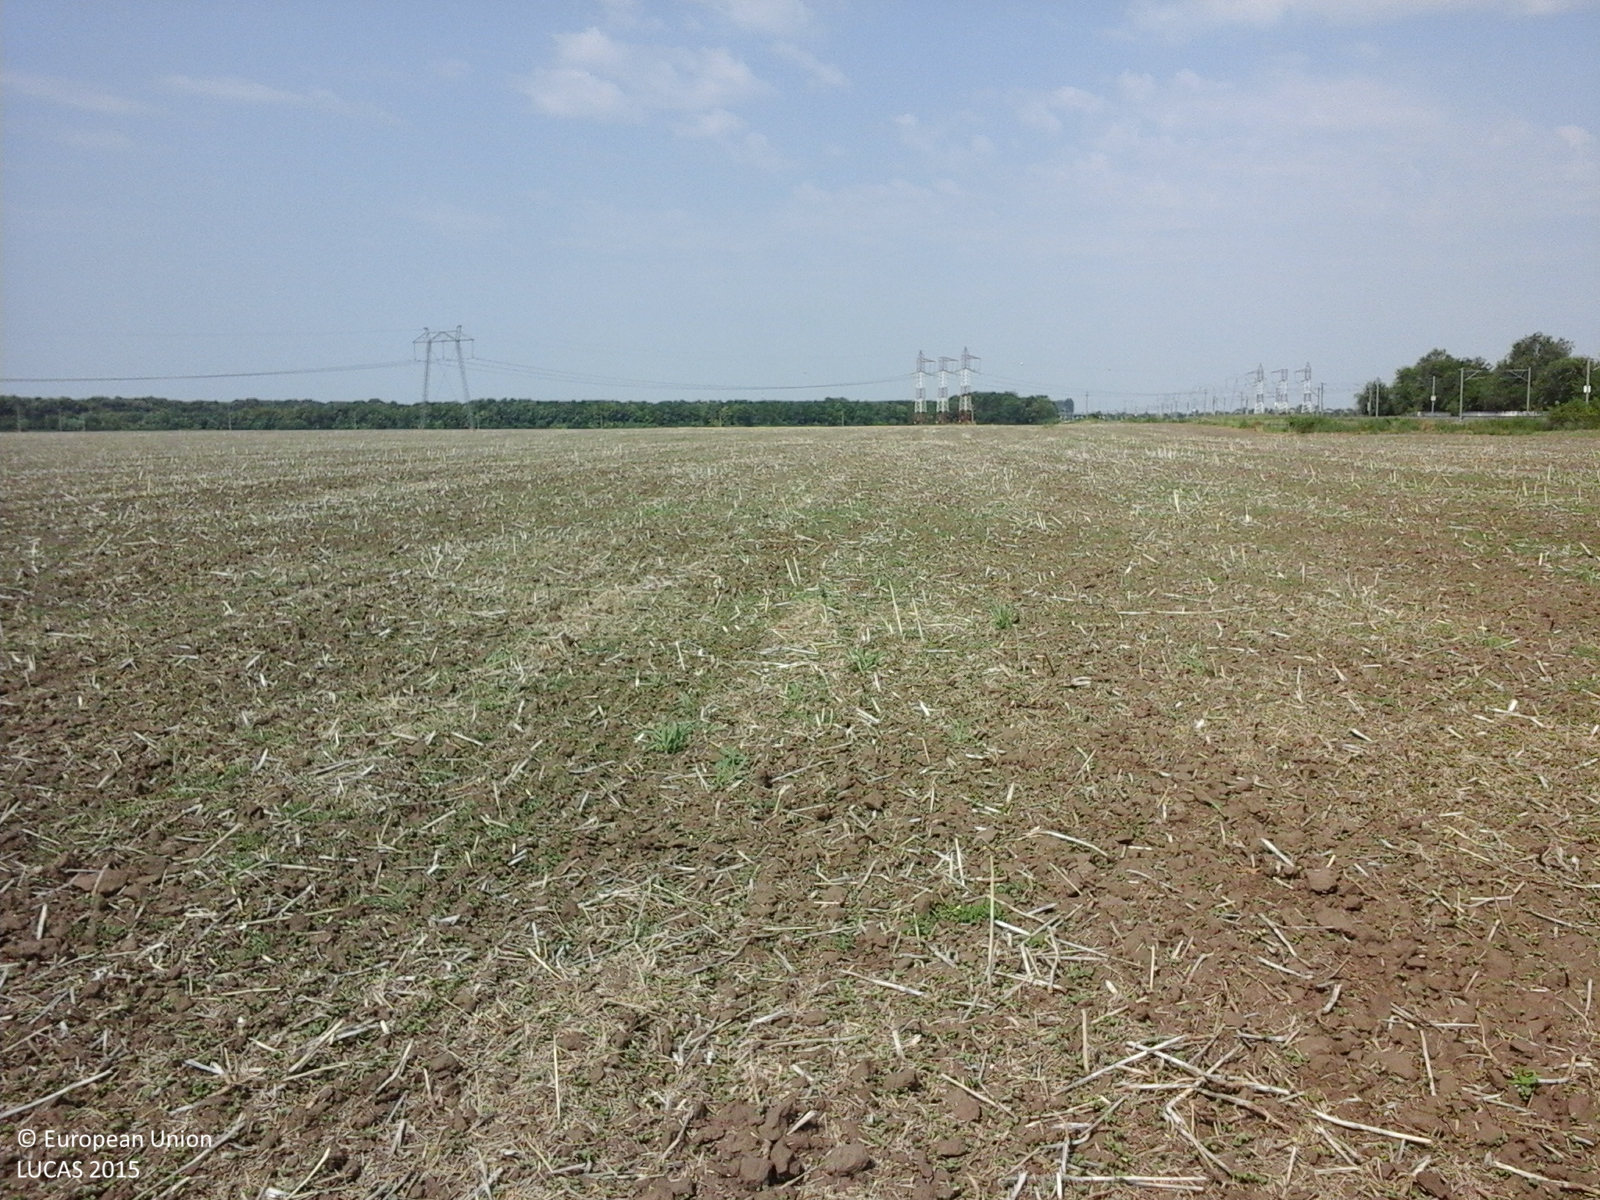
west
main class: Cropland
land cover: Rape and turnip rape
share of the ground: < 10 %
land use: Agriculture (excluding fallow land and kitchen gardens)
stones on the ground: < 10 %
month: July
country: RO
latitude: 44.4223
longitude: 27.5651
